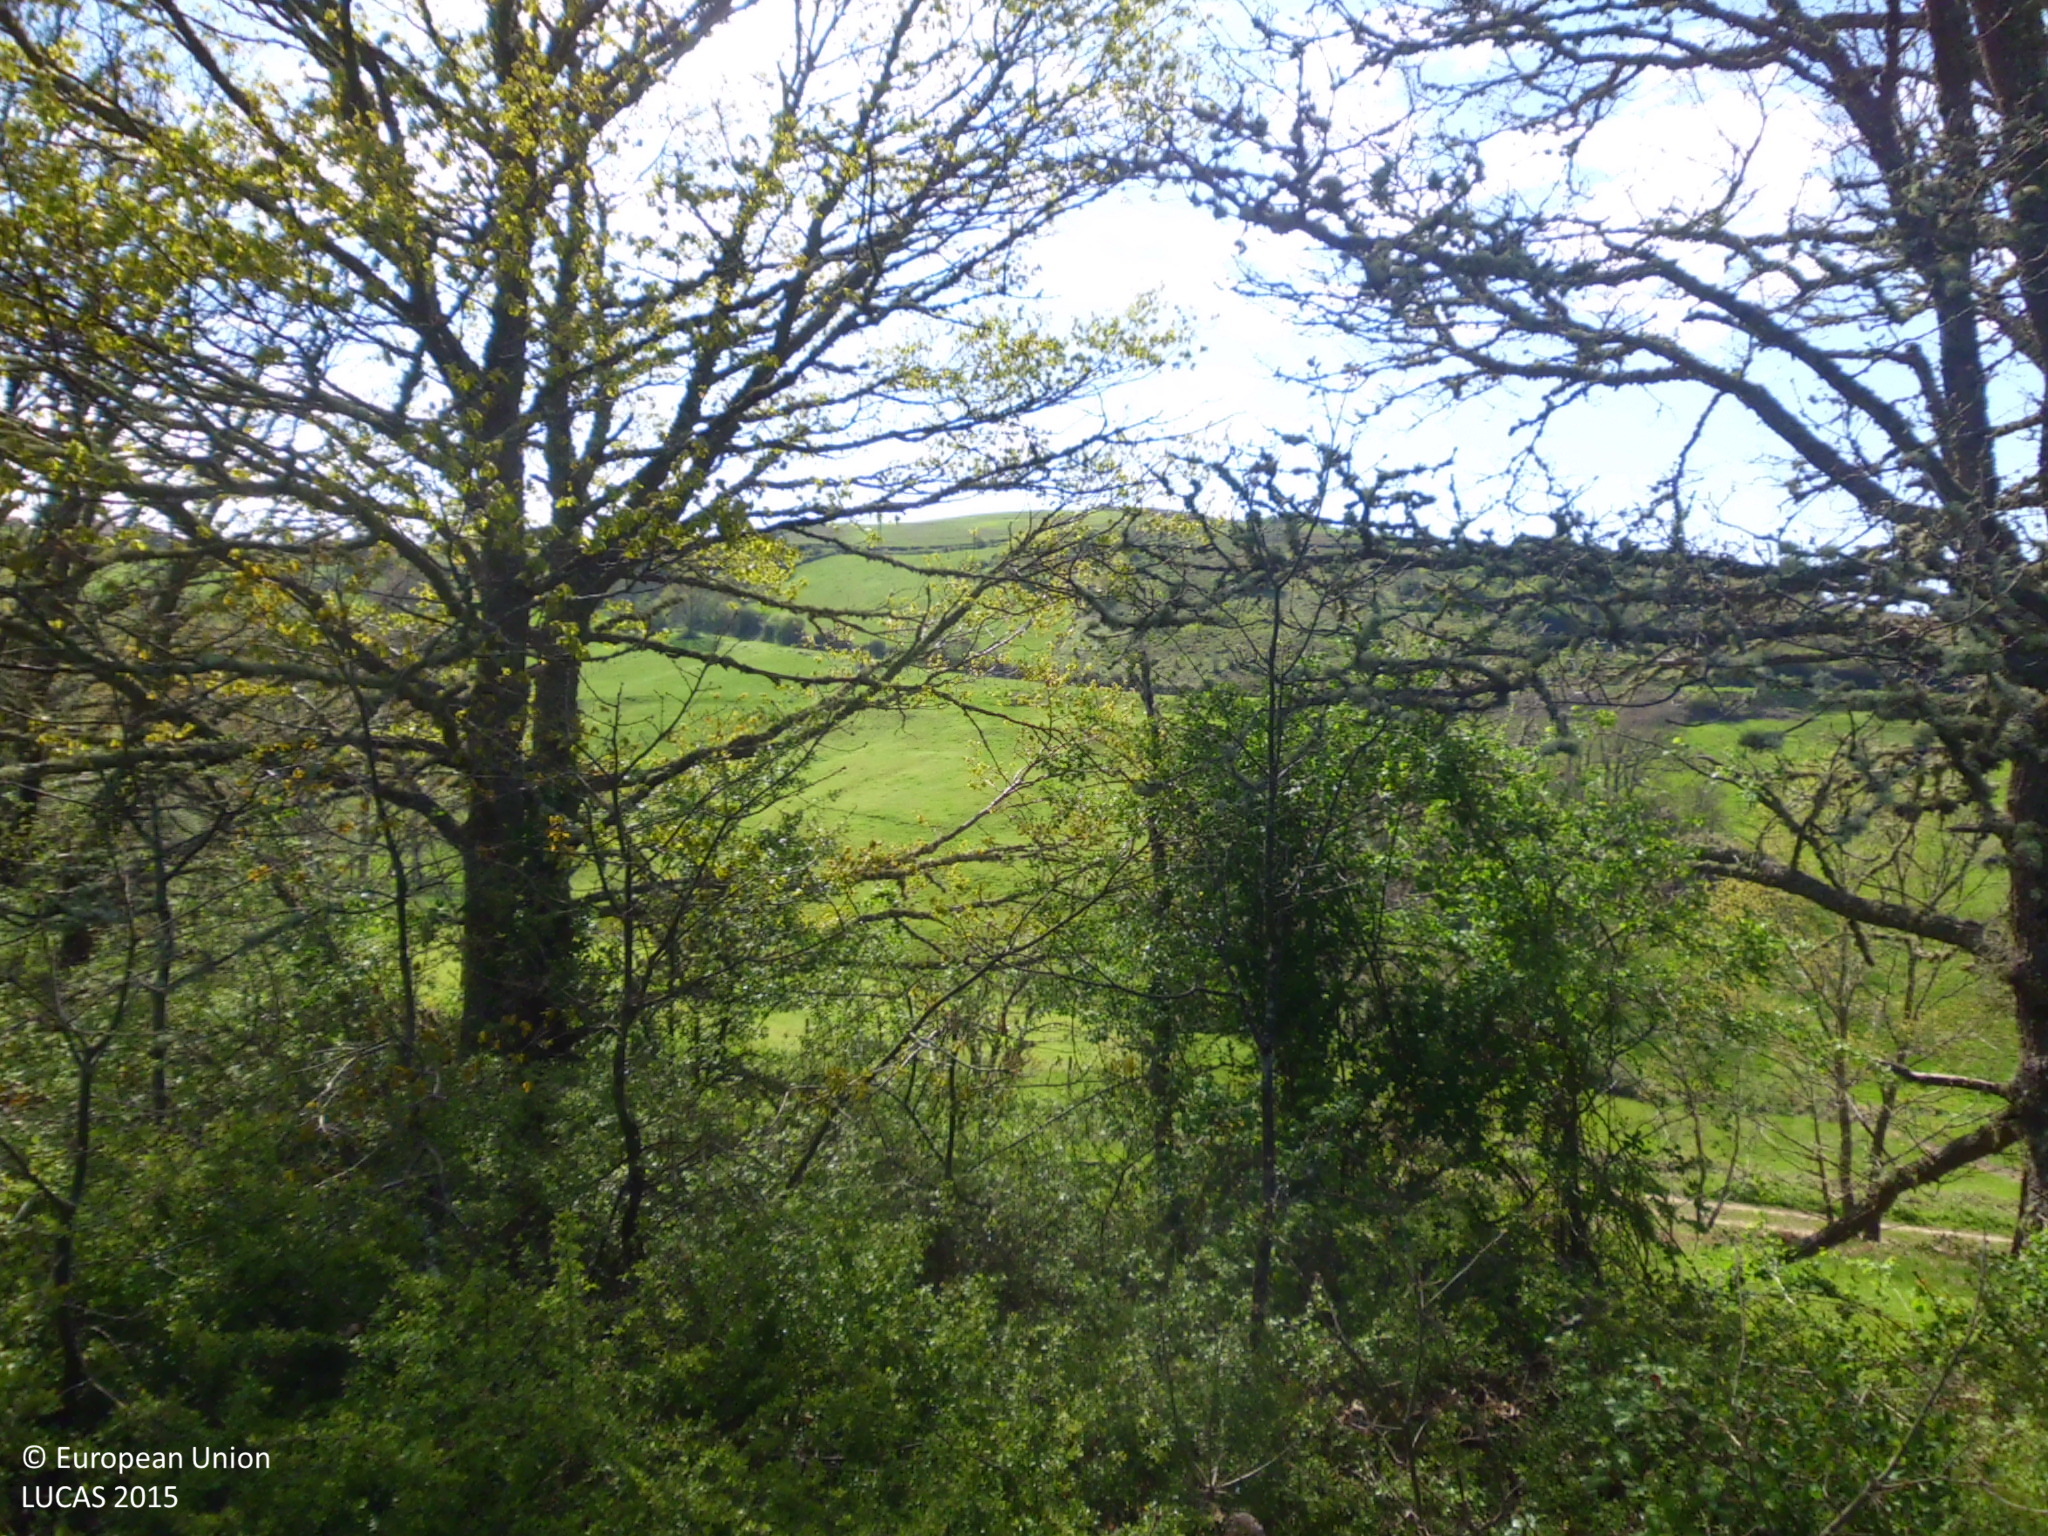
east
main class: Grassland
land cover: Grassland with sparse tree/shrub cover
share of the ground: 25 - 50 %
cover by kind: herbaceous plants 90 %, broadleaved forest trees 5 %, shrubs 5 %
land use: Abandoned areas
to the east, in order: Grassland with sparse tree/shrub cover; Broadleaved woodland; Tracks; Fences; Grassland without tree/shrub cover; Fences; Grassland without tree/shrub cover; Fences; Rivers and streams; Groves; Fences; Grassland without tree/shrub cover; Broadleaved woodland
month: May
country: ES
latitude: 42.8950
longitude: -3.9201
